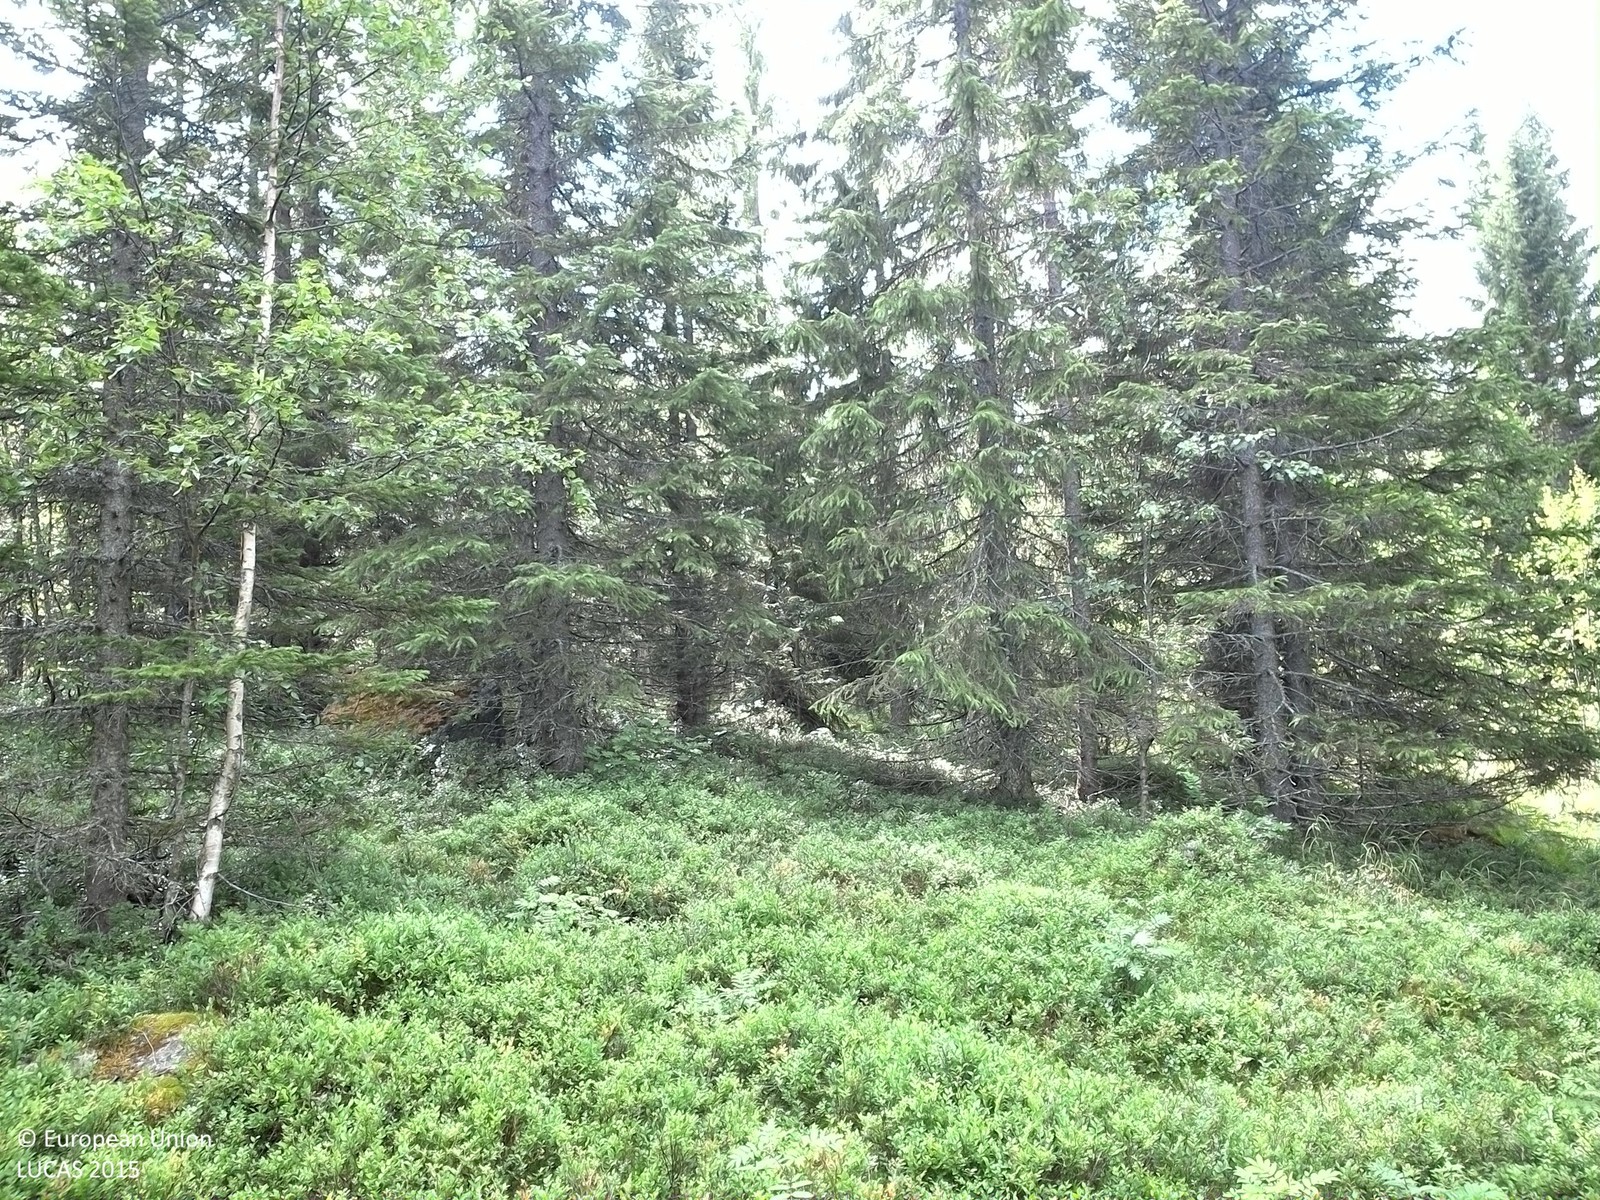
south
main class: Woodland
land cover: Spruce dominated coniferous woodland
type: boreal forest
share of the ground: 50 - 75 %
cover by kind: coniferous forest trees 55 %, shrubs 35 %, broadleaved forest trees 10 %
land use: Forestry
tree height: > 5 m
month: August
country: SE
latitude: 63.6466
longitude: 18.4349
